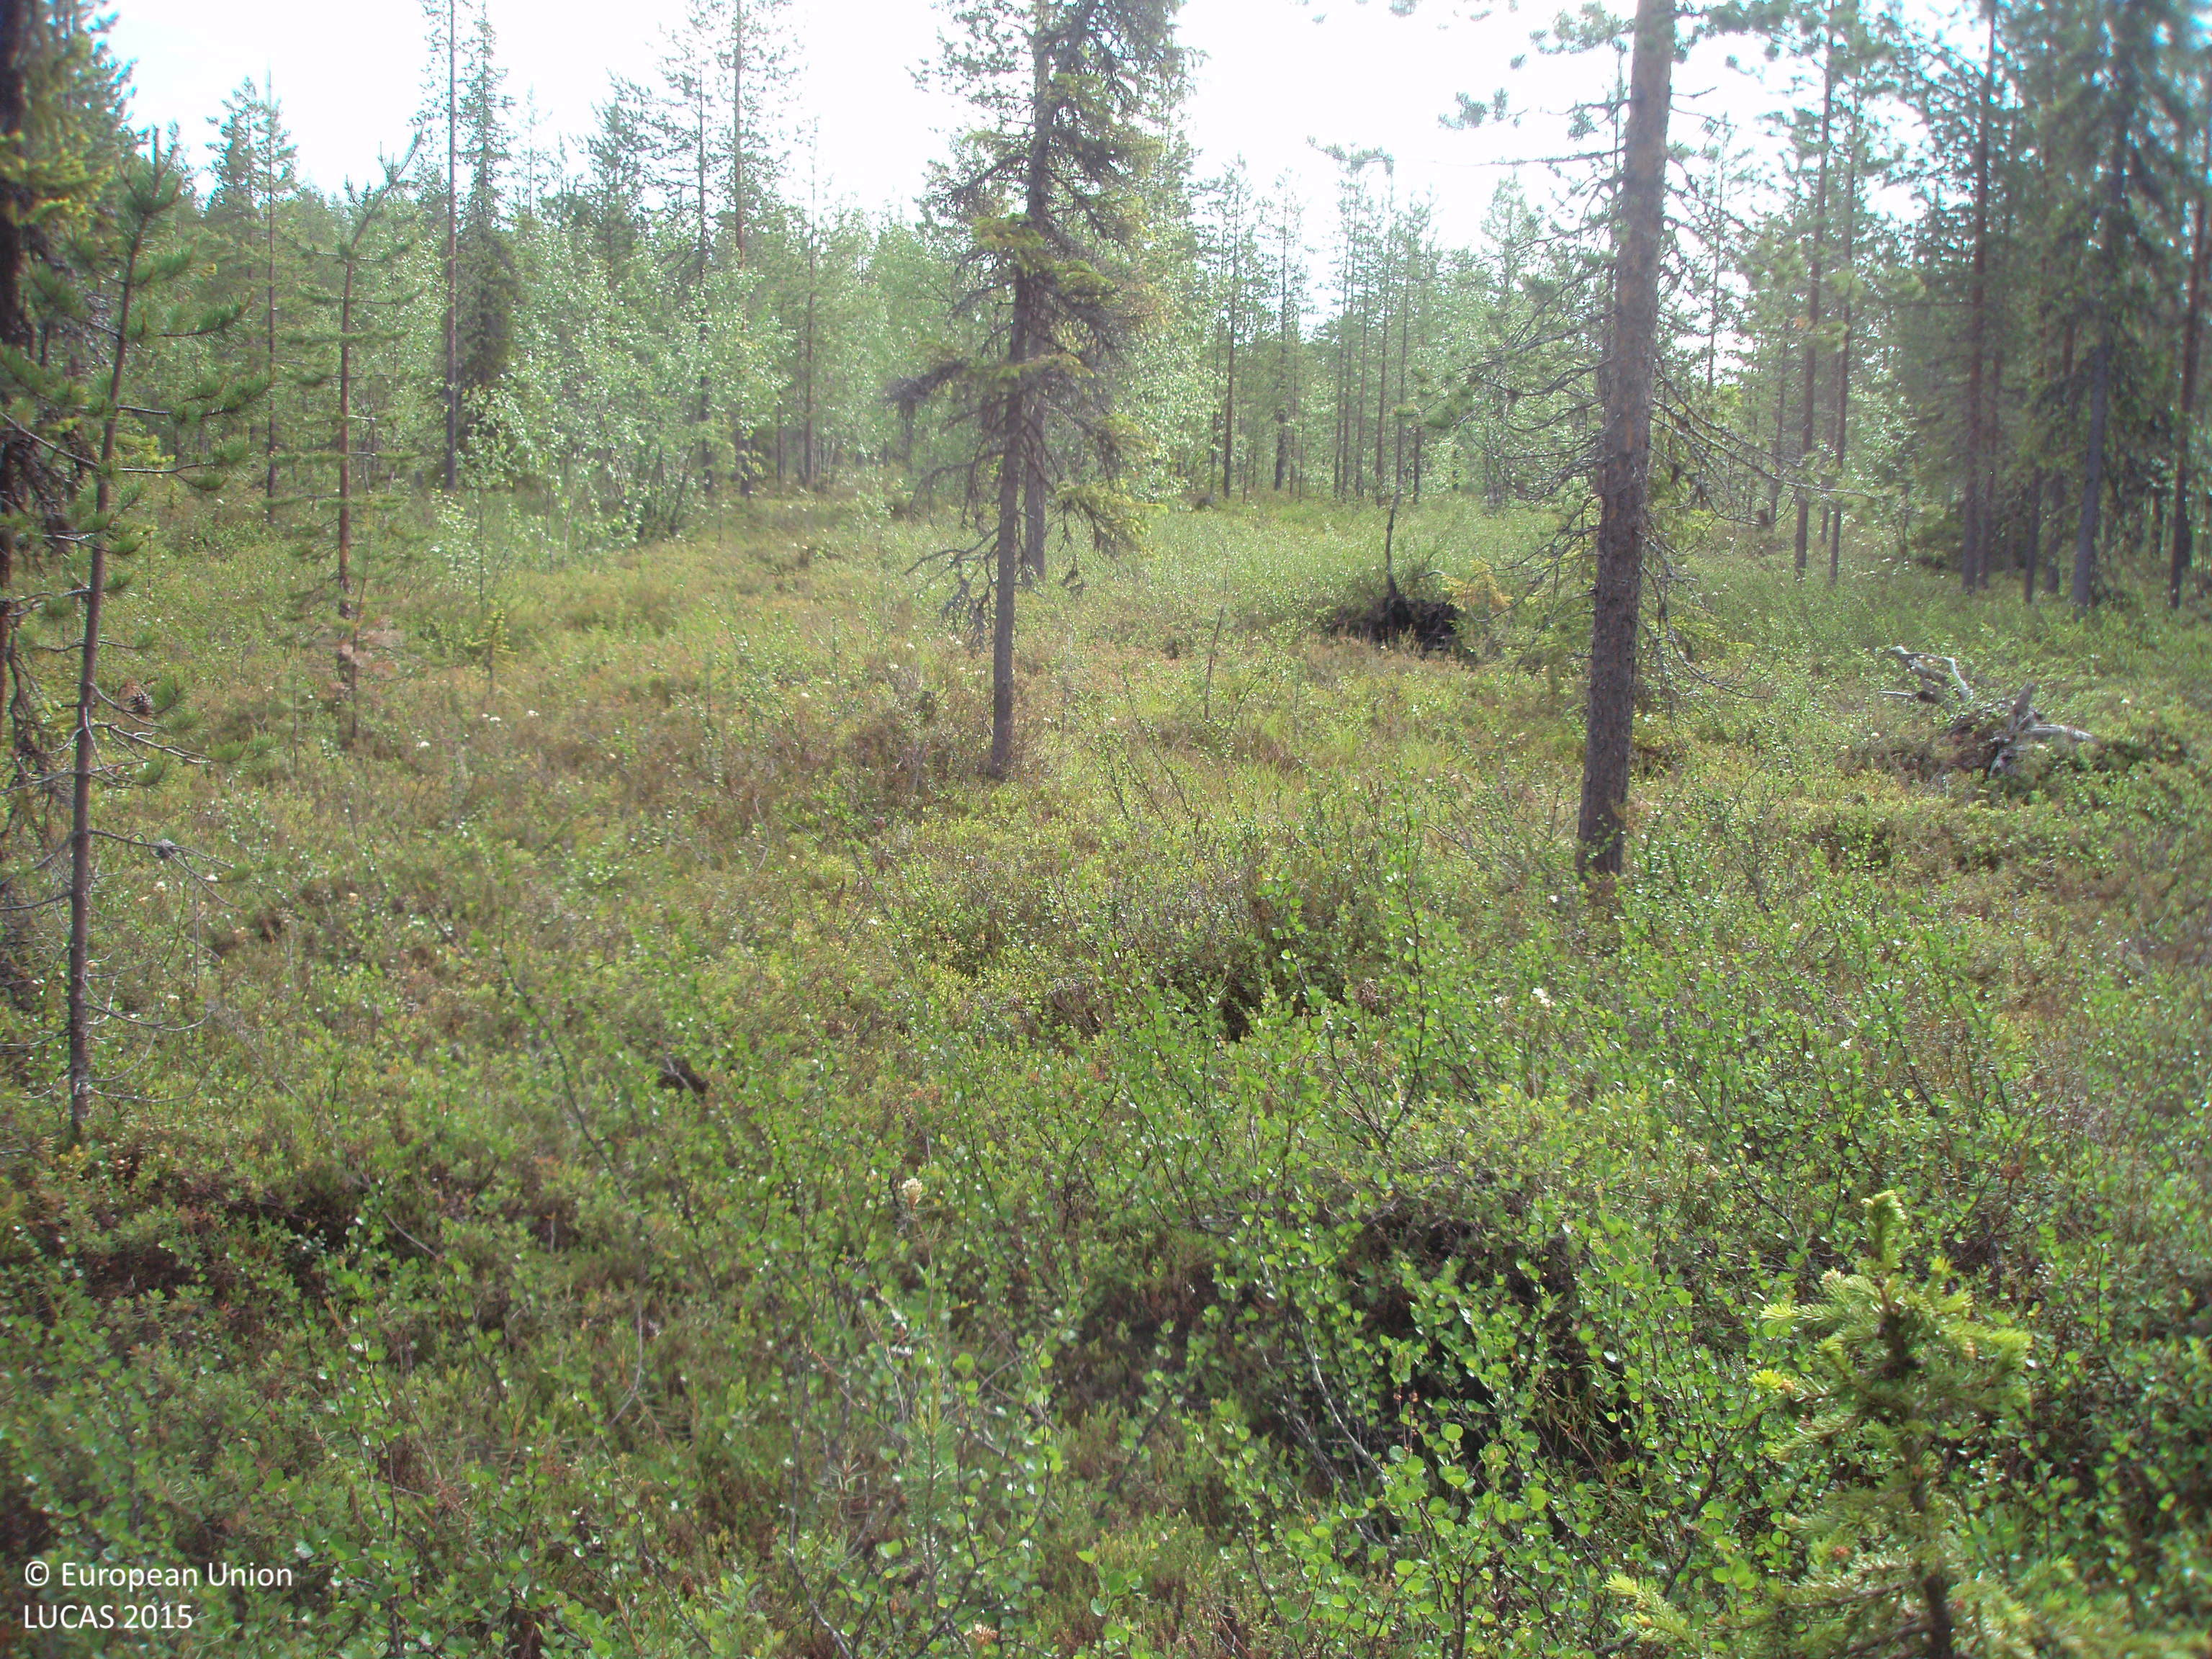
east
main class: Woodland
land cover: Pine dominated coniferous woodland
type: boreal forest
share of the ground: 50 - 75 %
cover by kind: coniferous forest trees 50 %, shrubs 40 %, broadleaved forest trees 10 %
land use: Forestry
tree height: > 5 m
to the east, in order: Pine dominated coniferous woodland; Other mixed woodland; Pine dominated mixed woodland
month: July
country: FI
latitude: 67.8245
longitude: 27.7875
